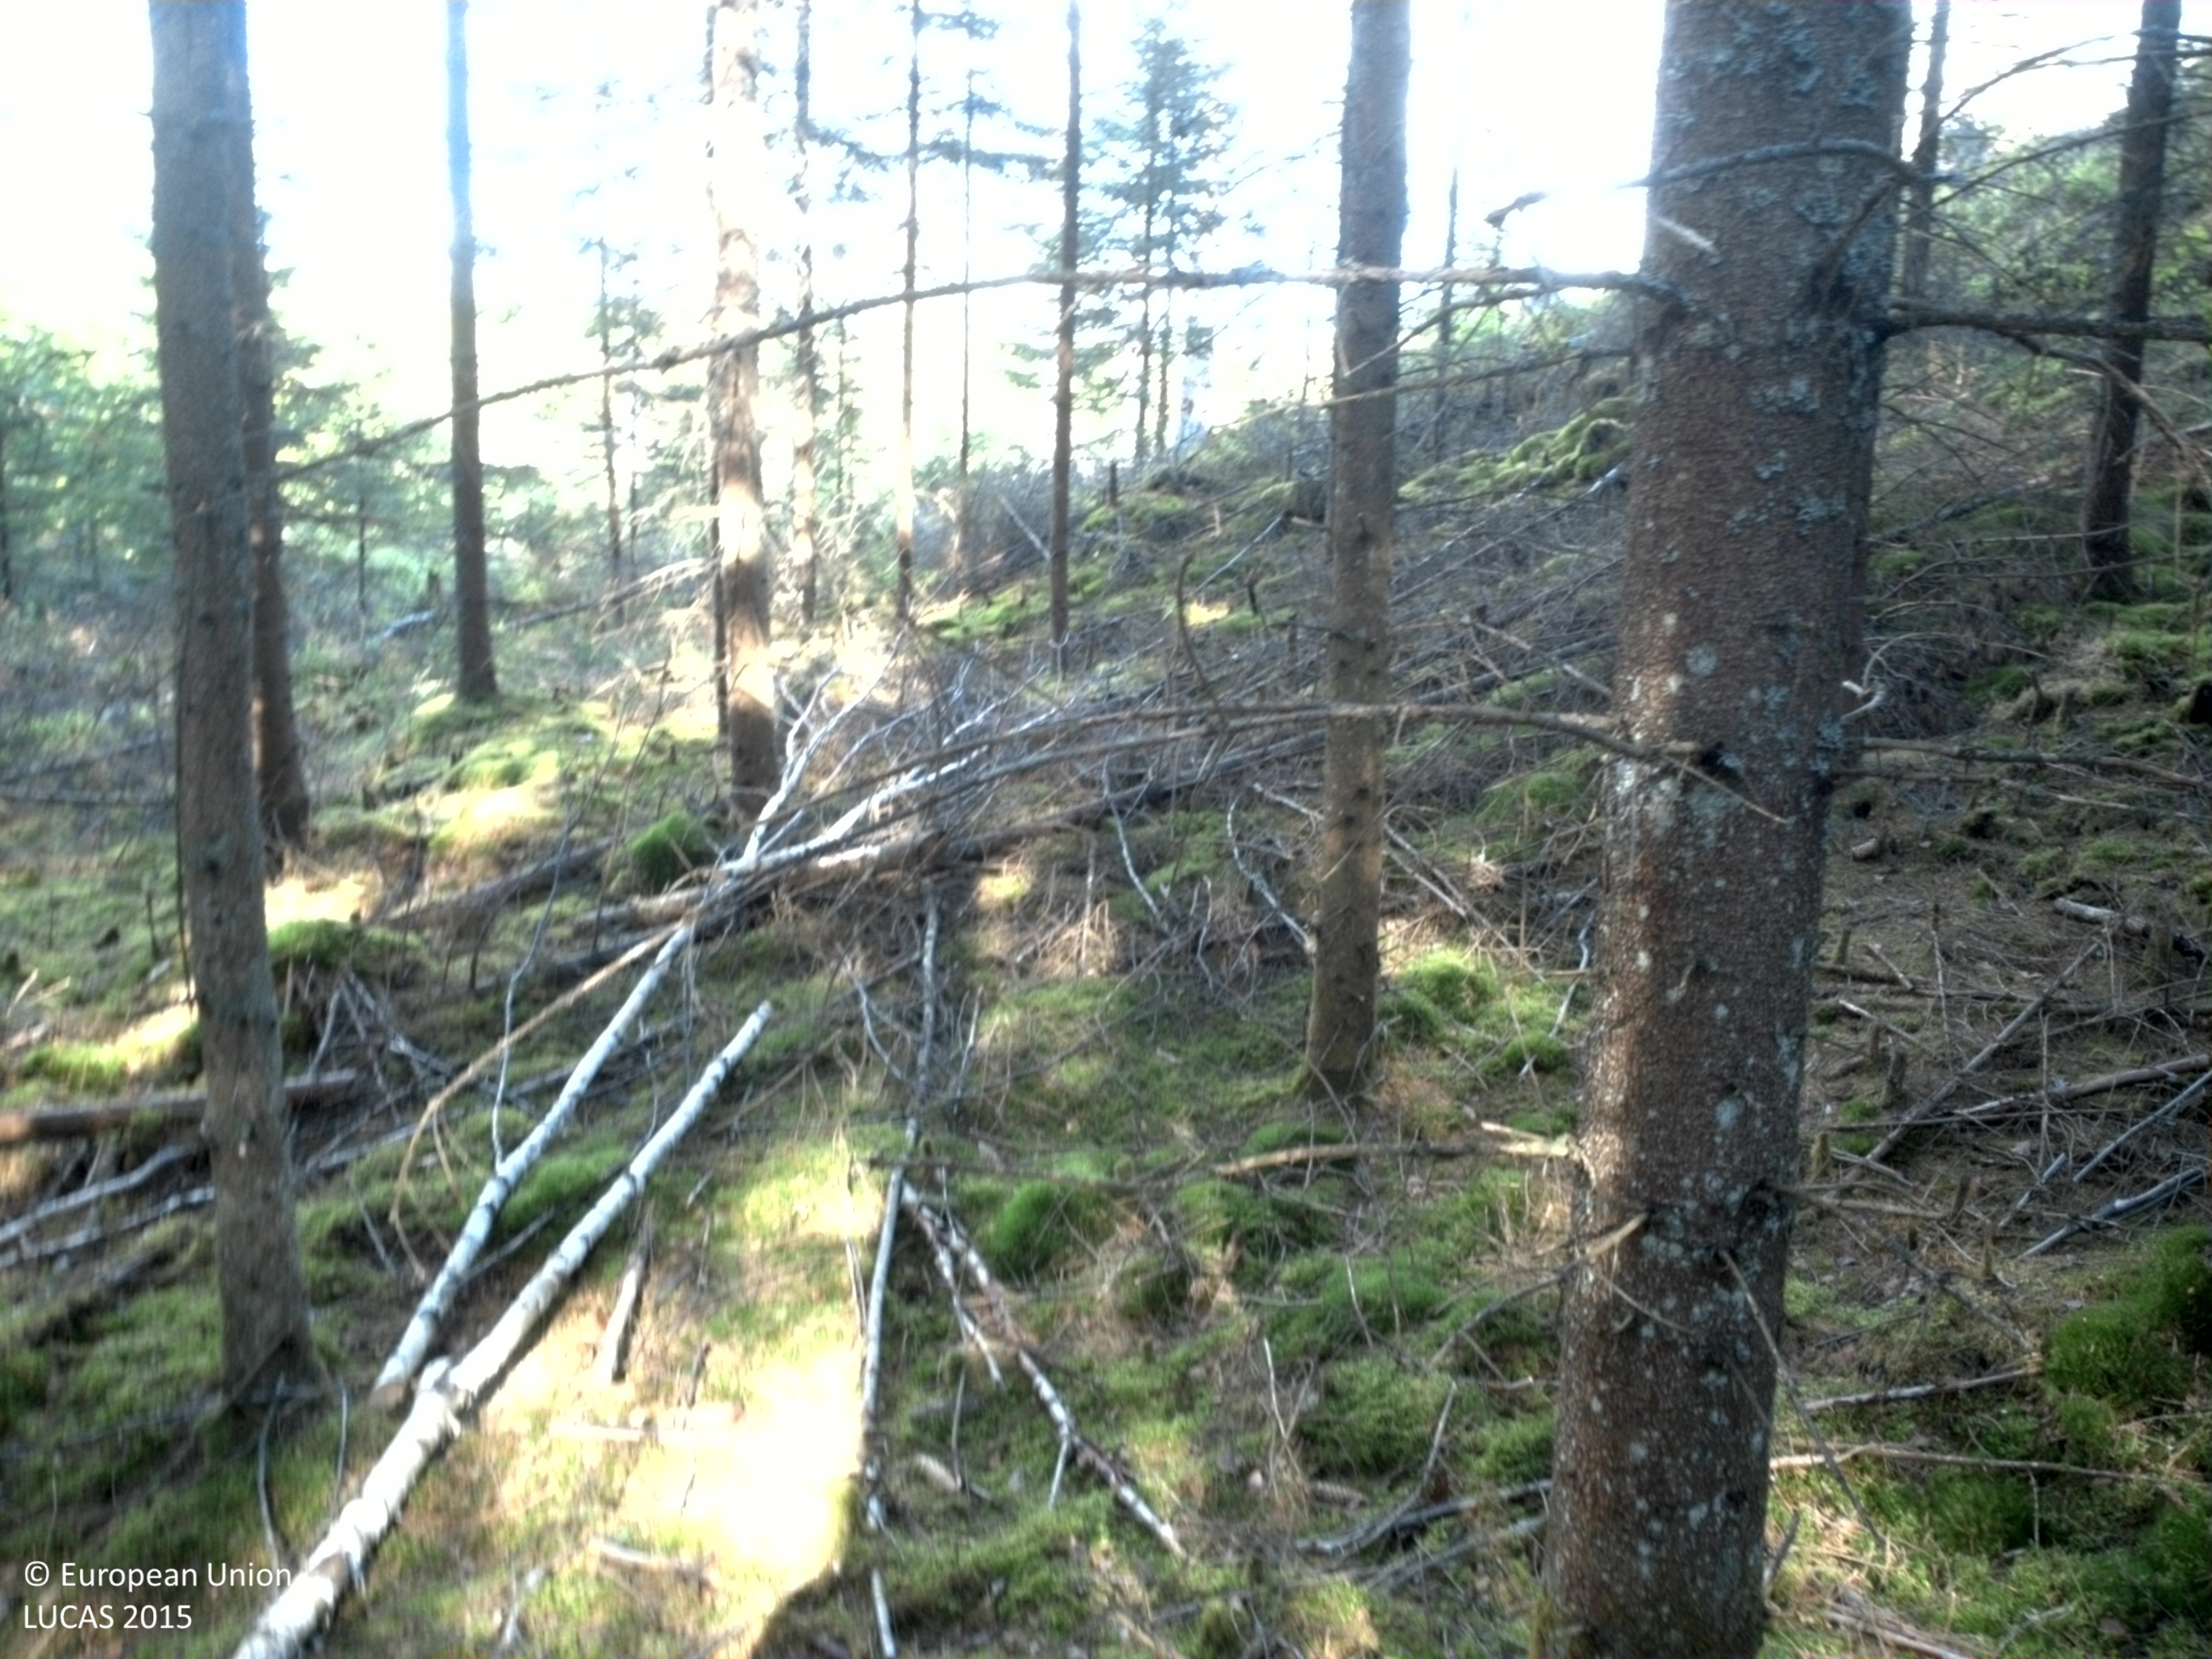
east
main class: Woodland
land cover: Spruce dominated coniferous woodland
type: boreal forest
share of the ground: > 75 %
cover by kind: coniferous forest trees 80 %, lichens and mosses 15 %, broadleaved forest trees 5 %
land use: Forestry
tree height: > 5 m
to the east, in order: Spruce dominated coniferous woodland; Pine dominated coniferous woodland; Electric lines; Shrubland without tree cover; Broadleaved woodland; Spruce dominated mixed woodland; Tracks; Broadleaved woodland; Ditches and canals; Broadleaved woodland
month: May
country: SE
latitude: 56.5667
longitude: 15.2549
